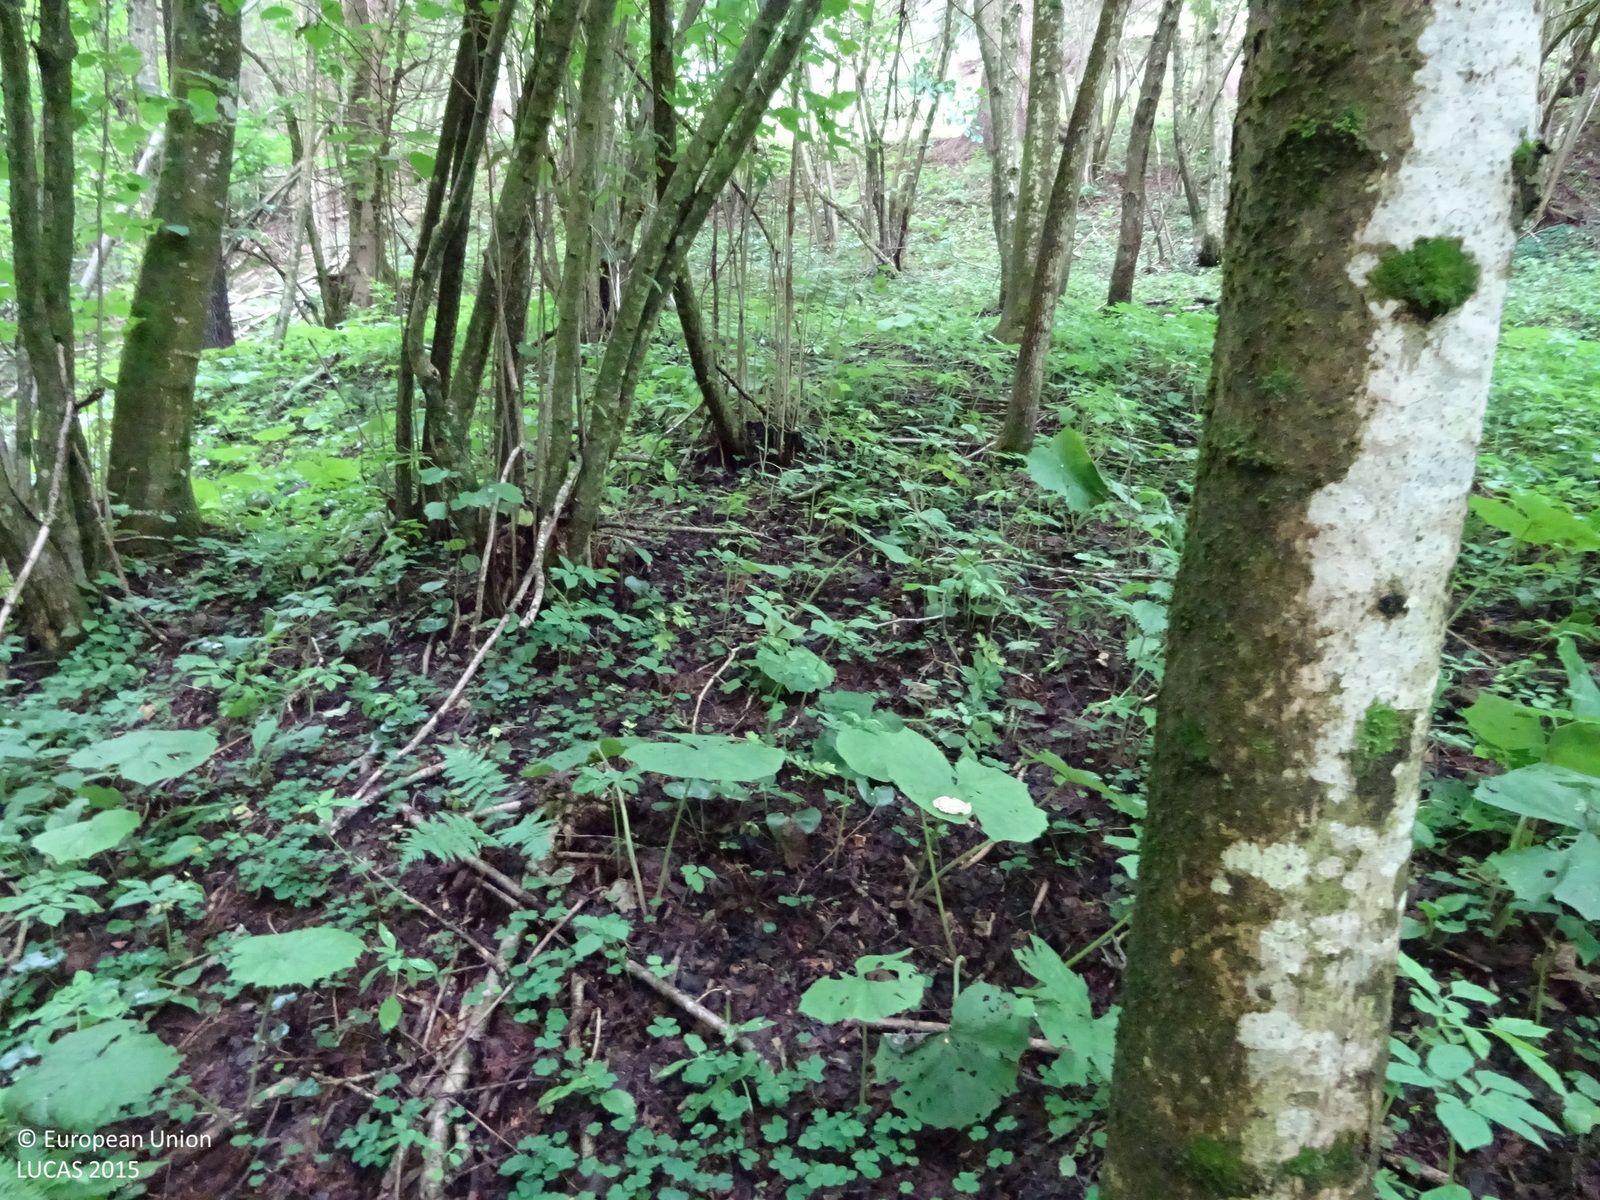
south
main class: Woodland
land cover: Spruce dominated mixed woodland
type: mountainous beech forest
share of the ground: > 75 %
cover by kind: broadleaved forest trees 65 %, coniferous forest trees 25 %, shrubs 10 %
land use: Forestry
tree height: > 5 m
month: July
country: AT
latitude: 47.2380
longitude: 15.5089
